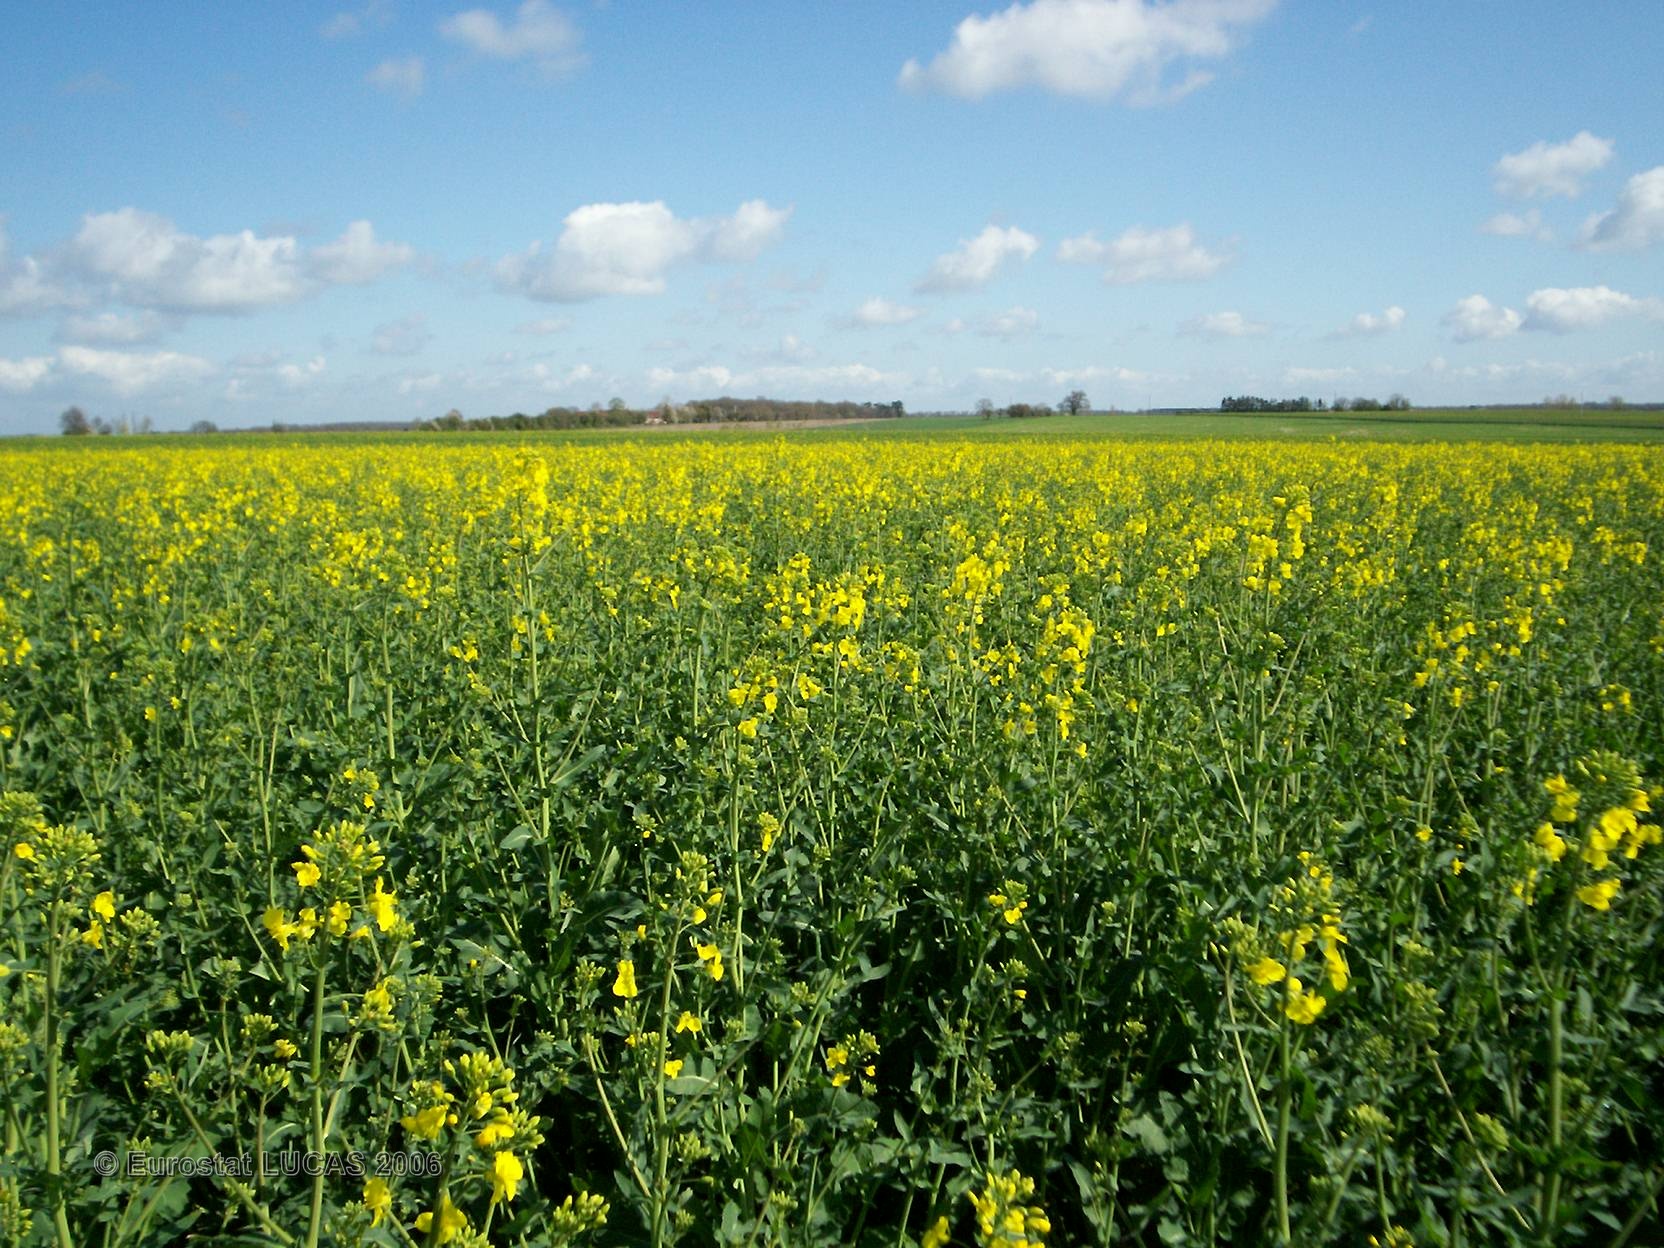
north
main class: Cropland
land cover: Rape and turnip rape
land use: Agriculture (excluding fallow land and kitchen gardens)
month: April
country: FR
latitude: 47.0017
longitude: 0.9754
